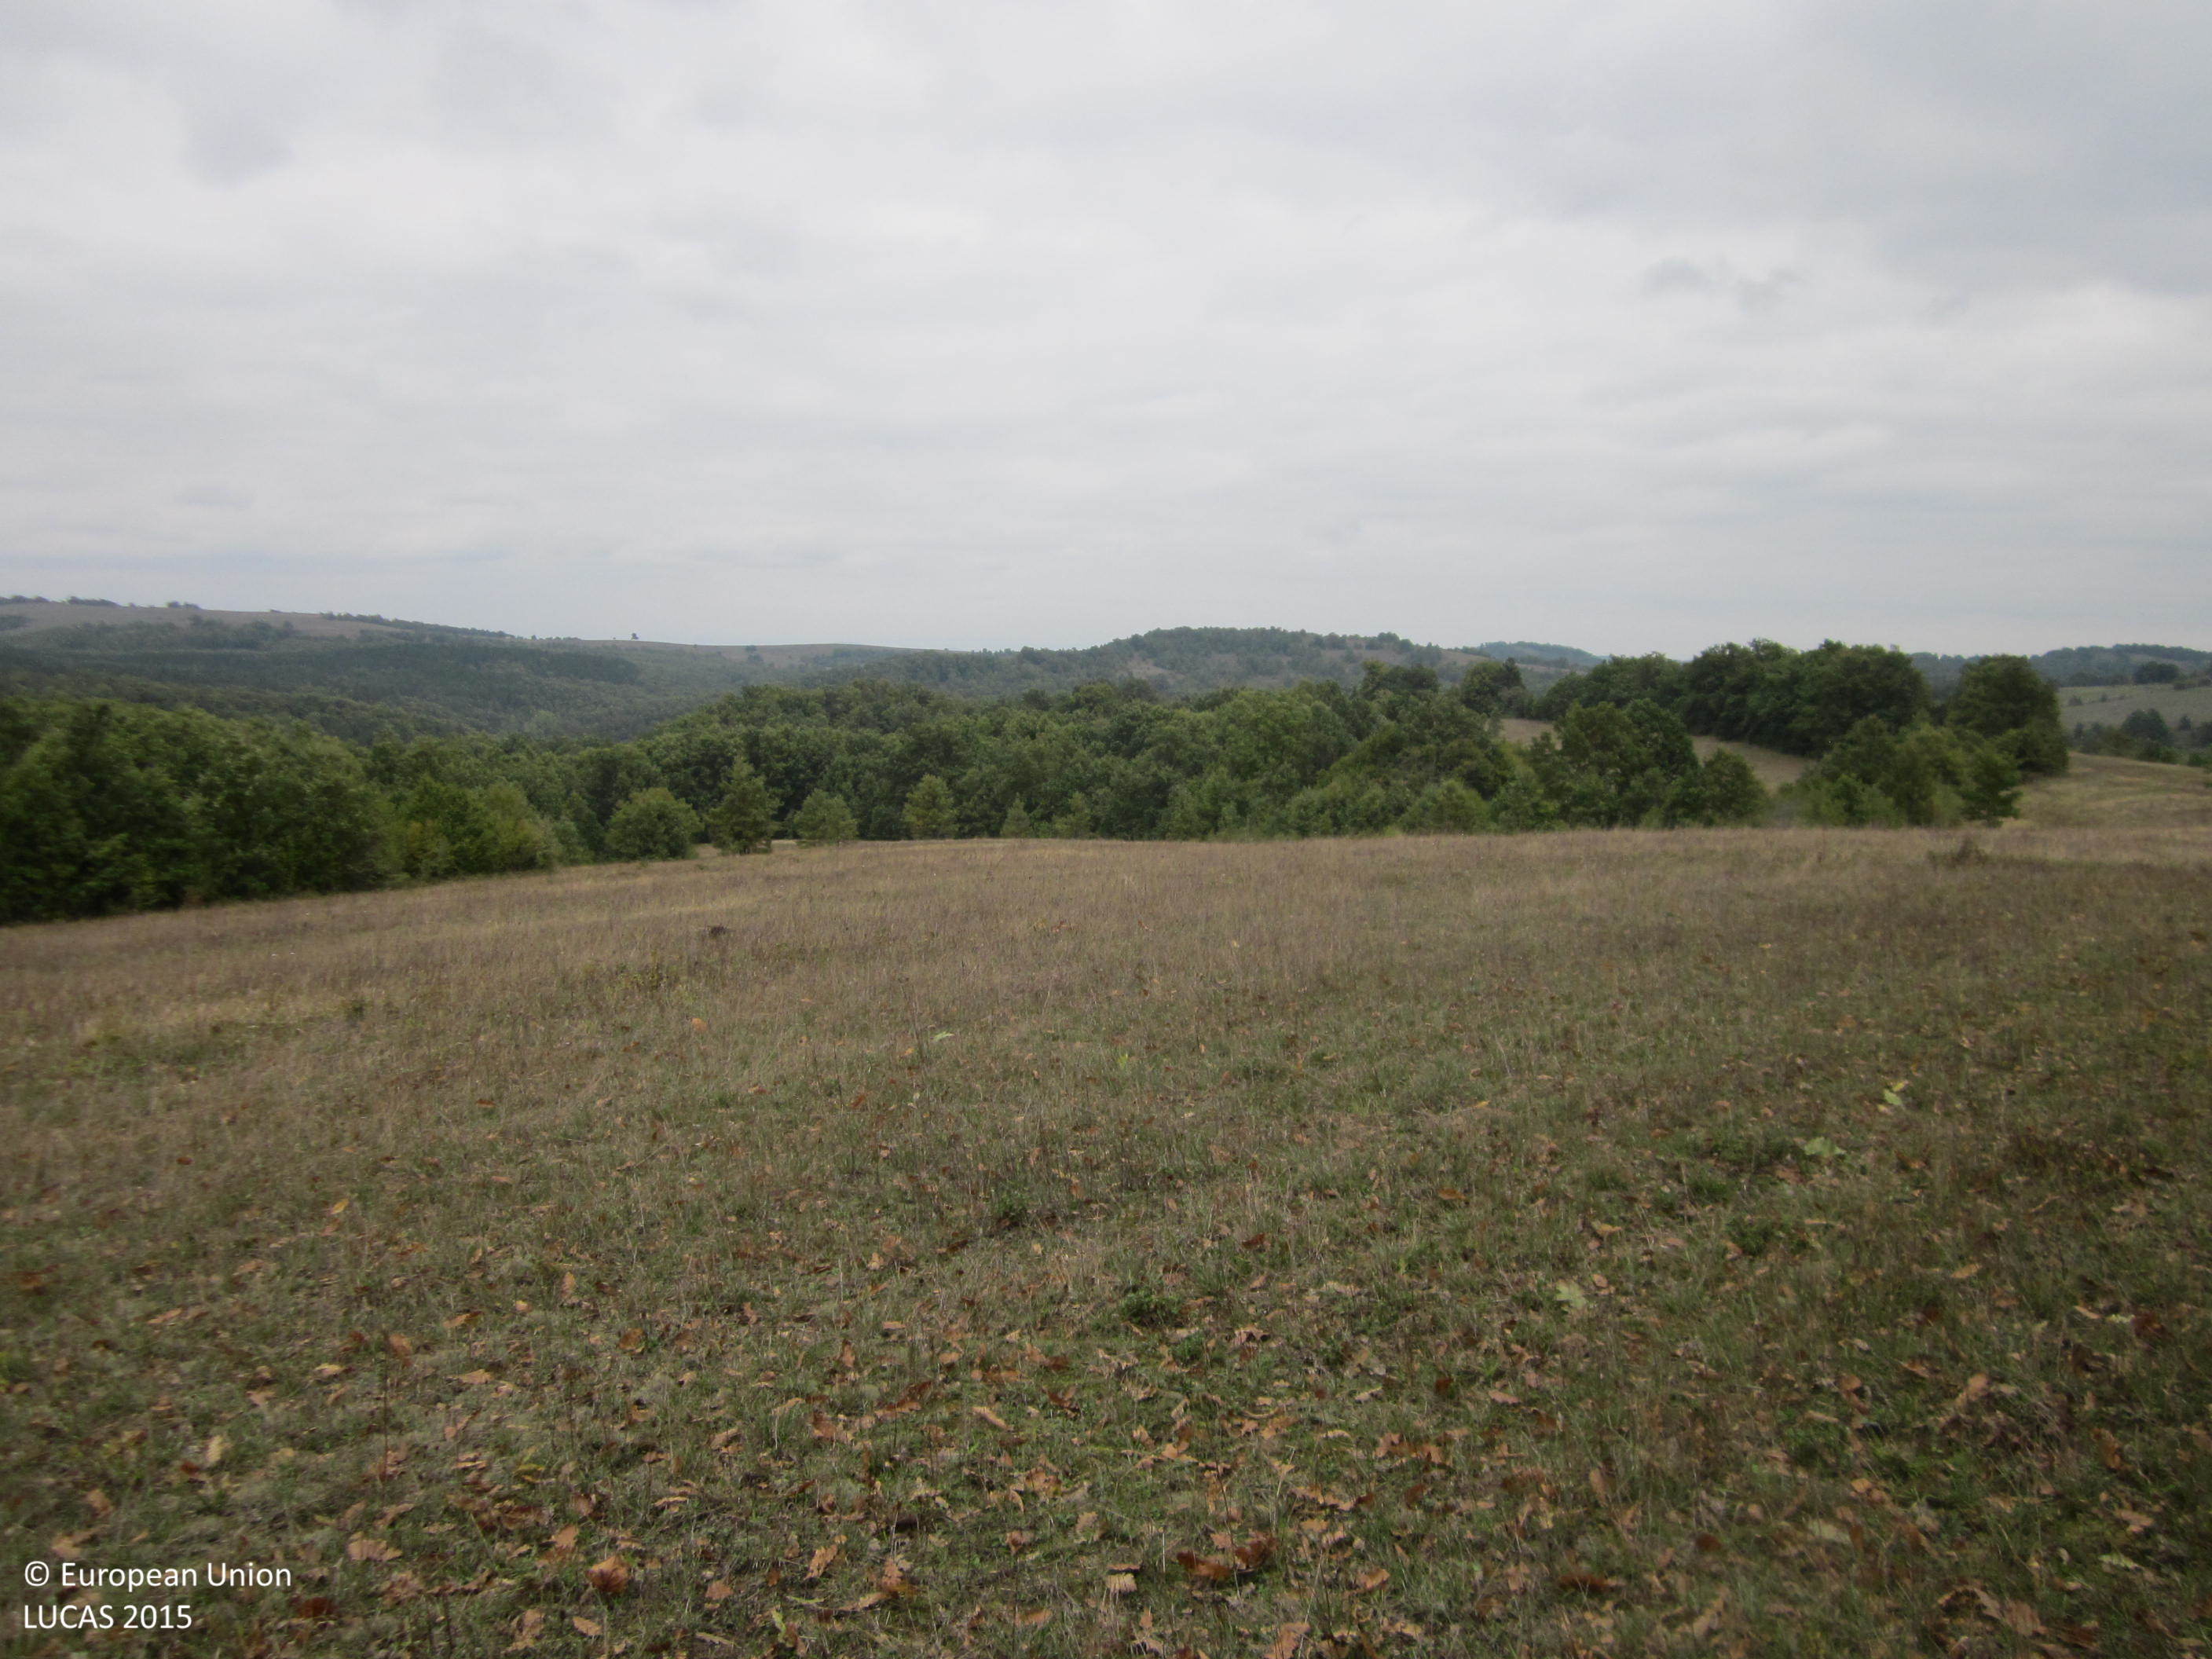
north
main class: Grassland
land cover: Grassland without tree/shrub cover
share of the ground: > 75 %
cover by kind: herbaceous plants 100 %
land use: Agriculture (excluding fallow land and kitchen gardens)
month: October
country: BG
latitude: 42.2260
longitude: 27.3756
